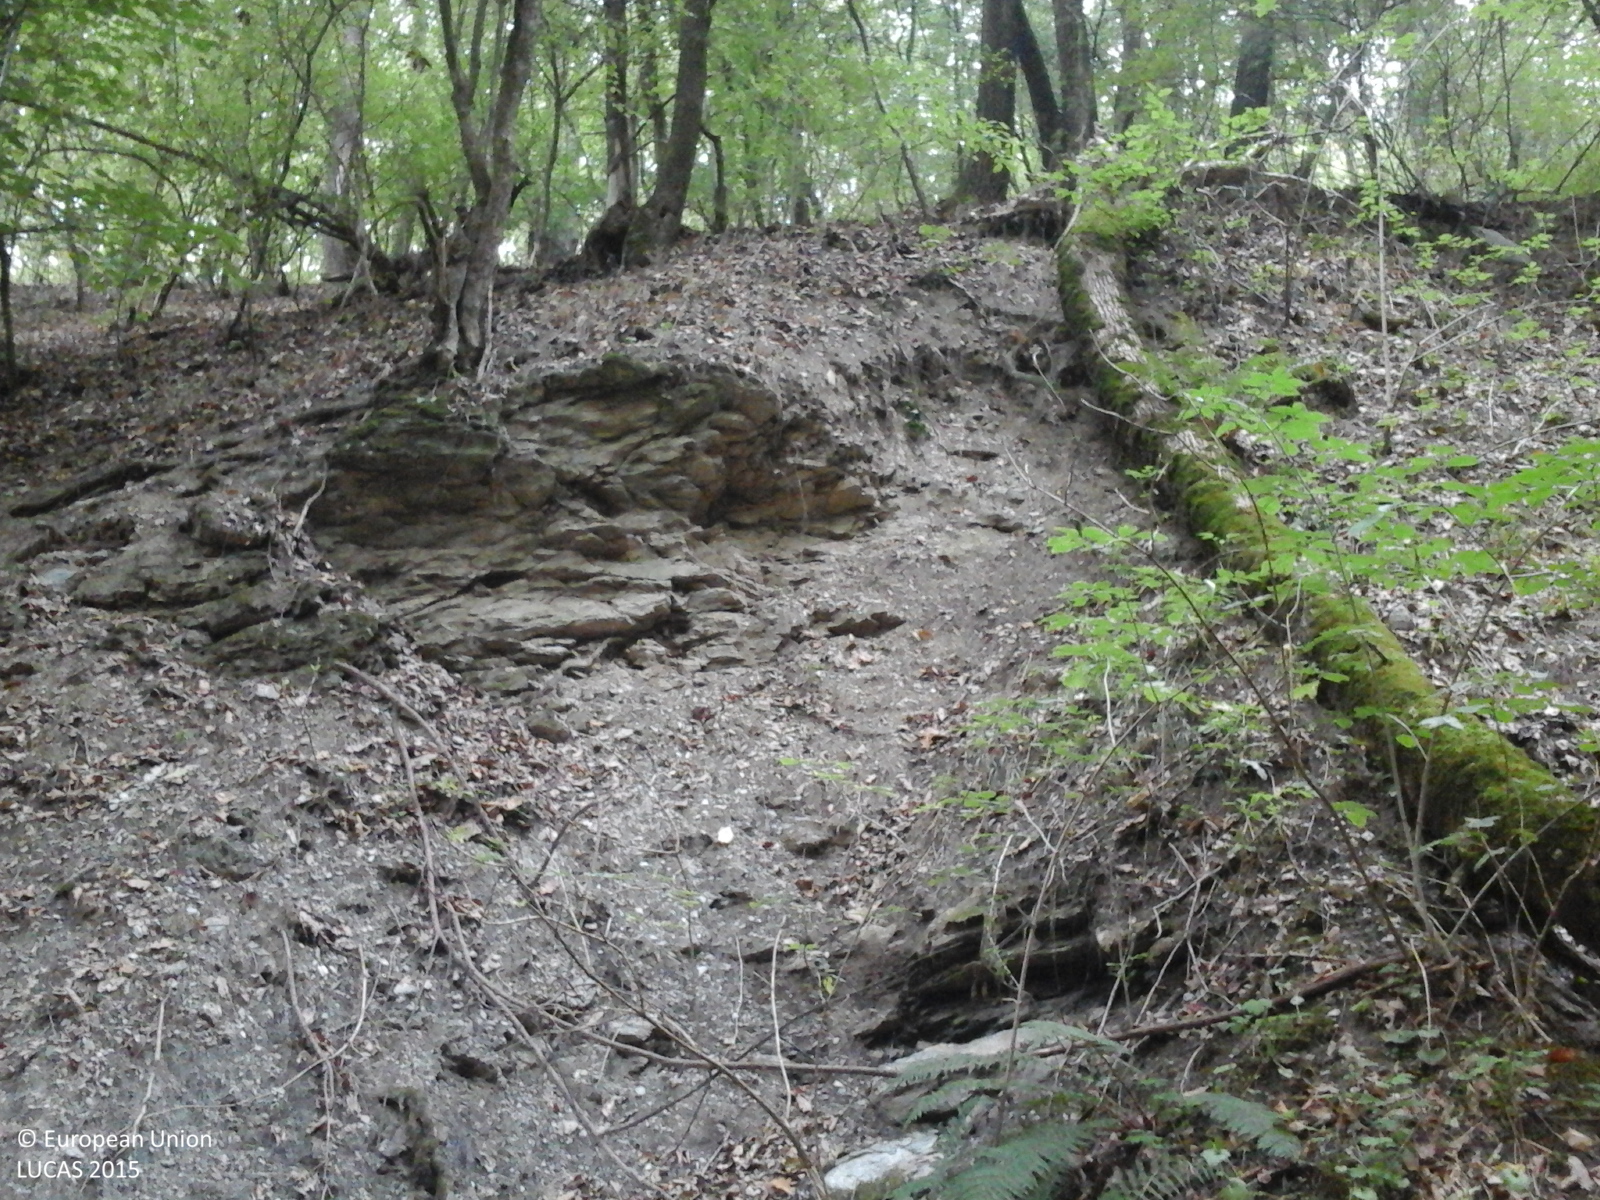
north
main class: Woodland
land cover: Broadleaved woodland
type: mesophytic deciduous forest
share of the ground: > 75 %
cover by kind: broadleaved forest trees 100 %
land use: Forestry
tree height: > 5 m
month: September
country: RO
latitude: 45.9033
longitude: 22.8268
